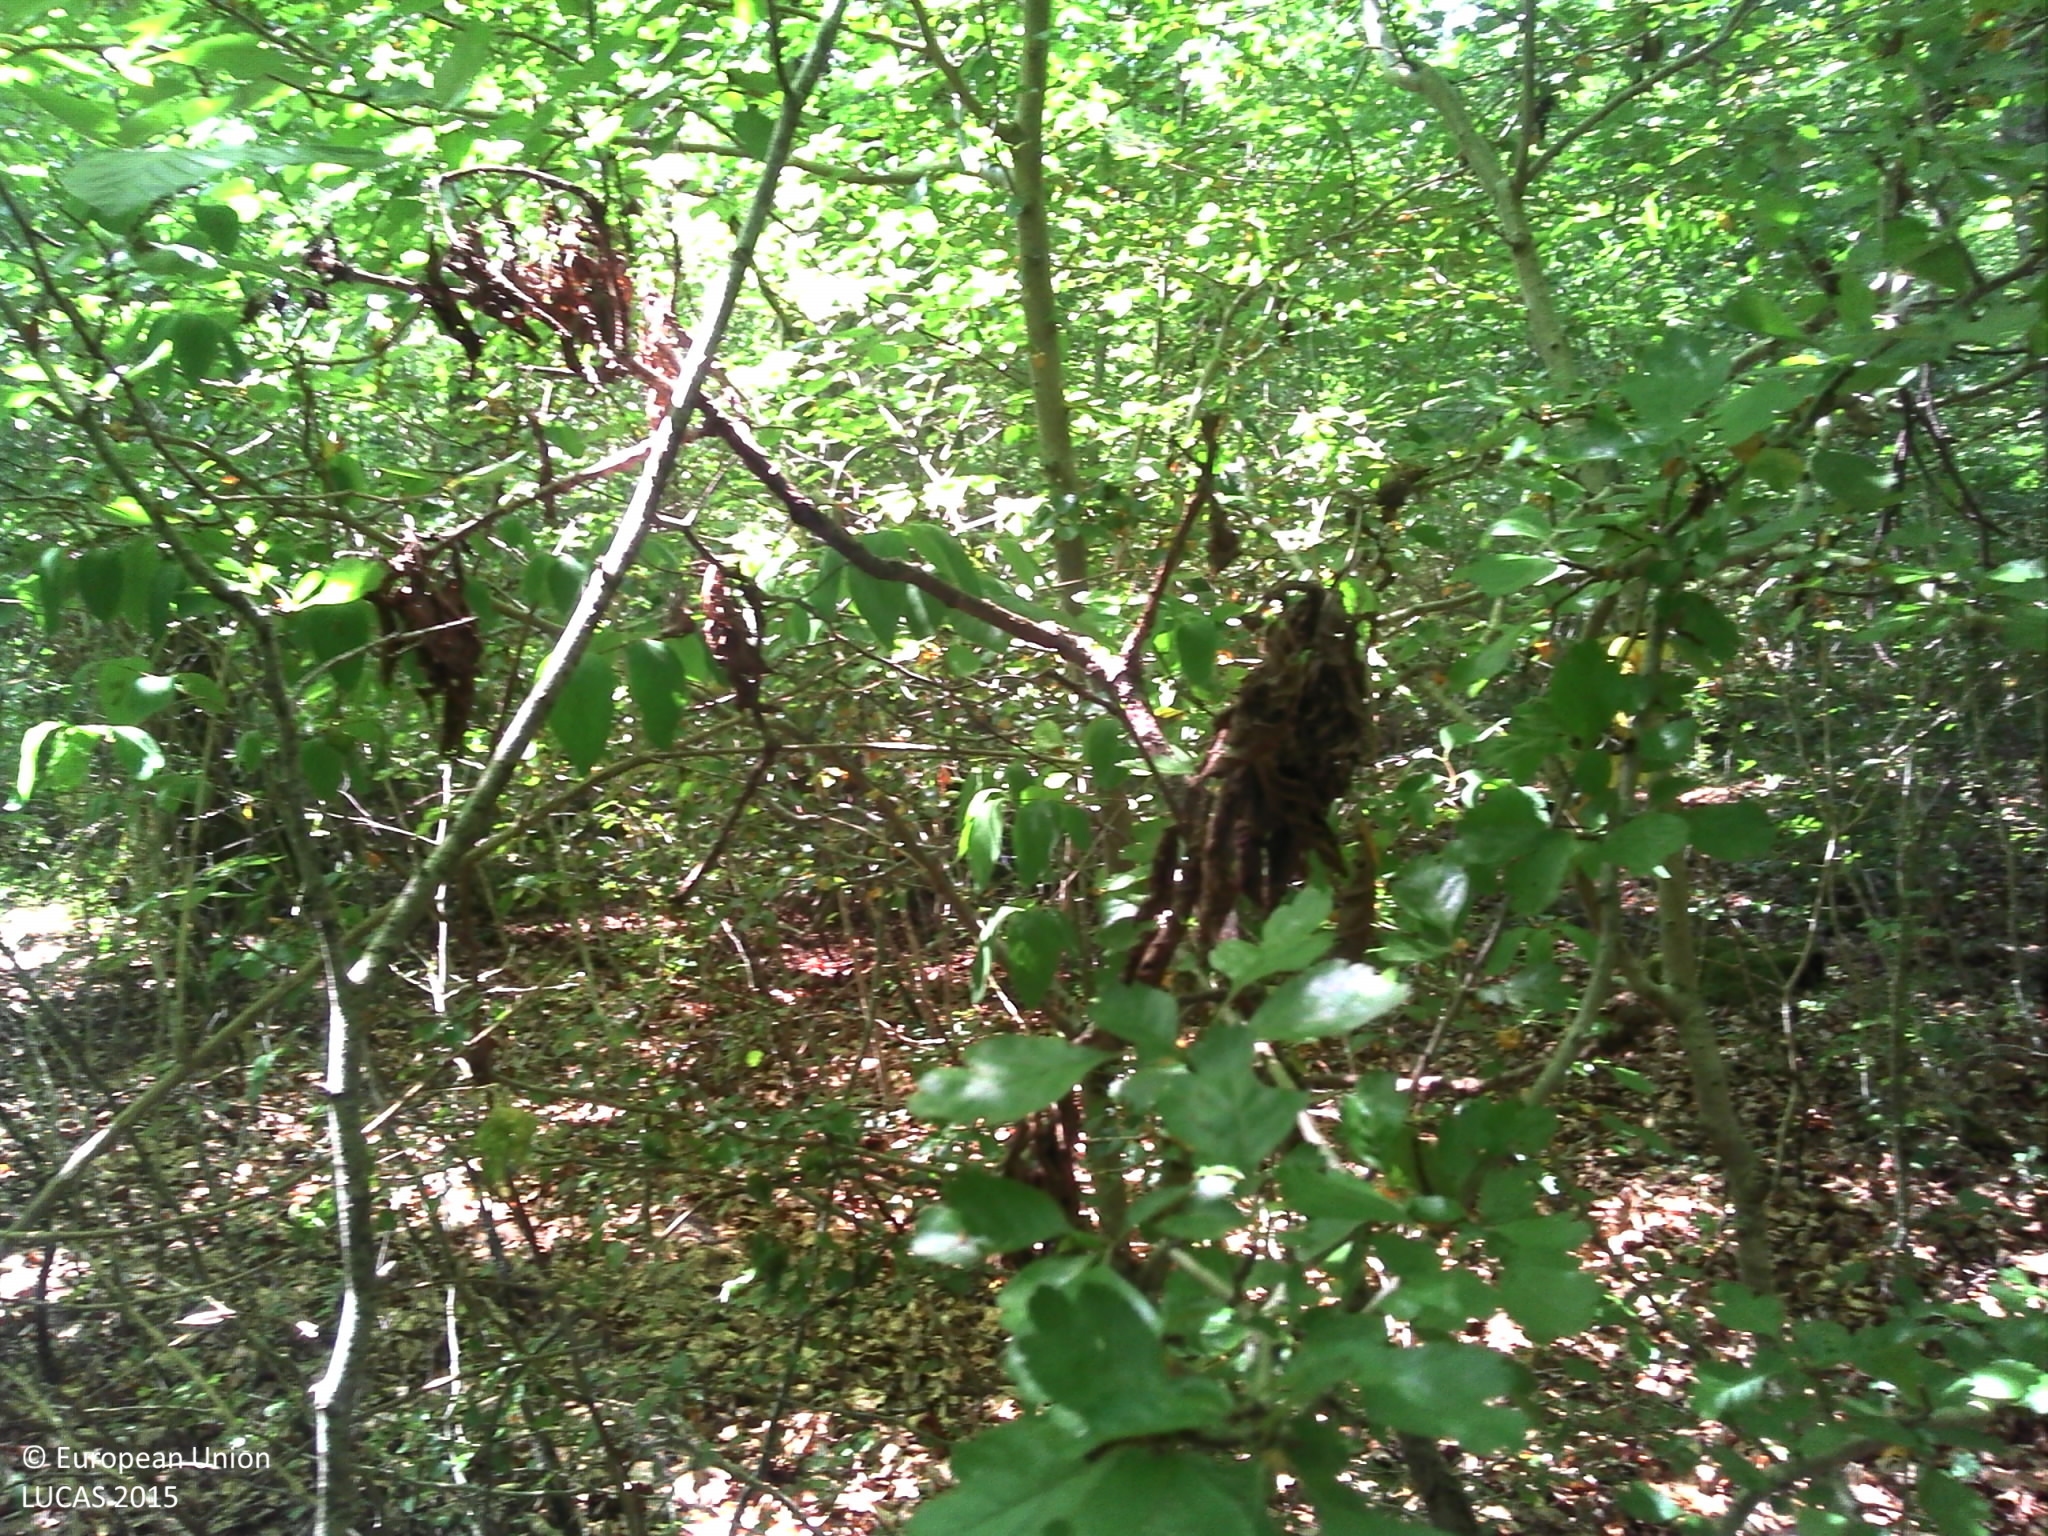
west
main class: Woodland
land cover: Broadleaved woodland
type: acidophilous oak and oak-birch forest
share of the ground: > 75 %
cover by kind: broadleaved forest trees 90 %, herbaceous plants 5 %, lichens and mosses 5 %
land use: Forestry
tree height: > 5 m
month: July
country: FR
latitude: 48.0254
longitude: 4.7288
